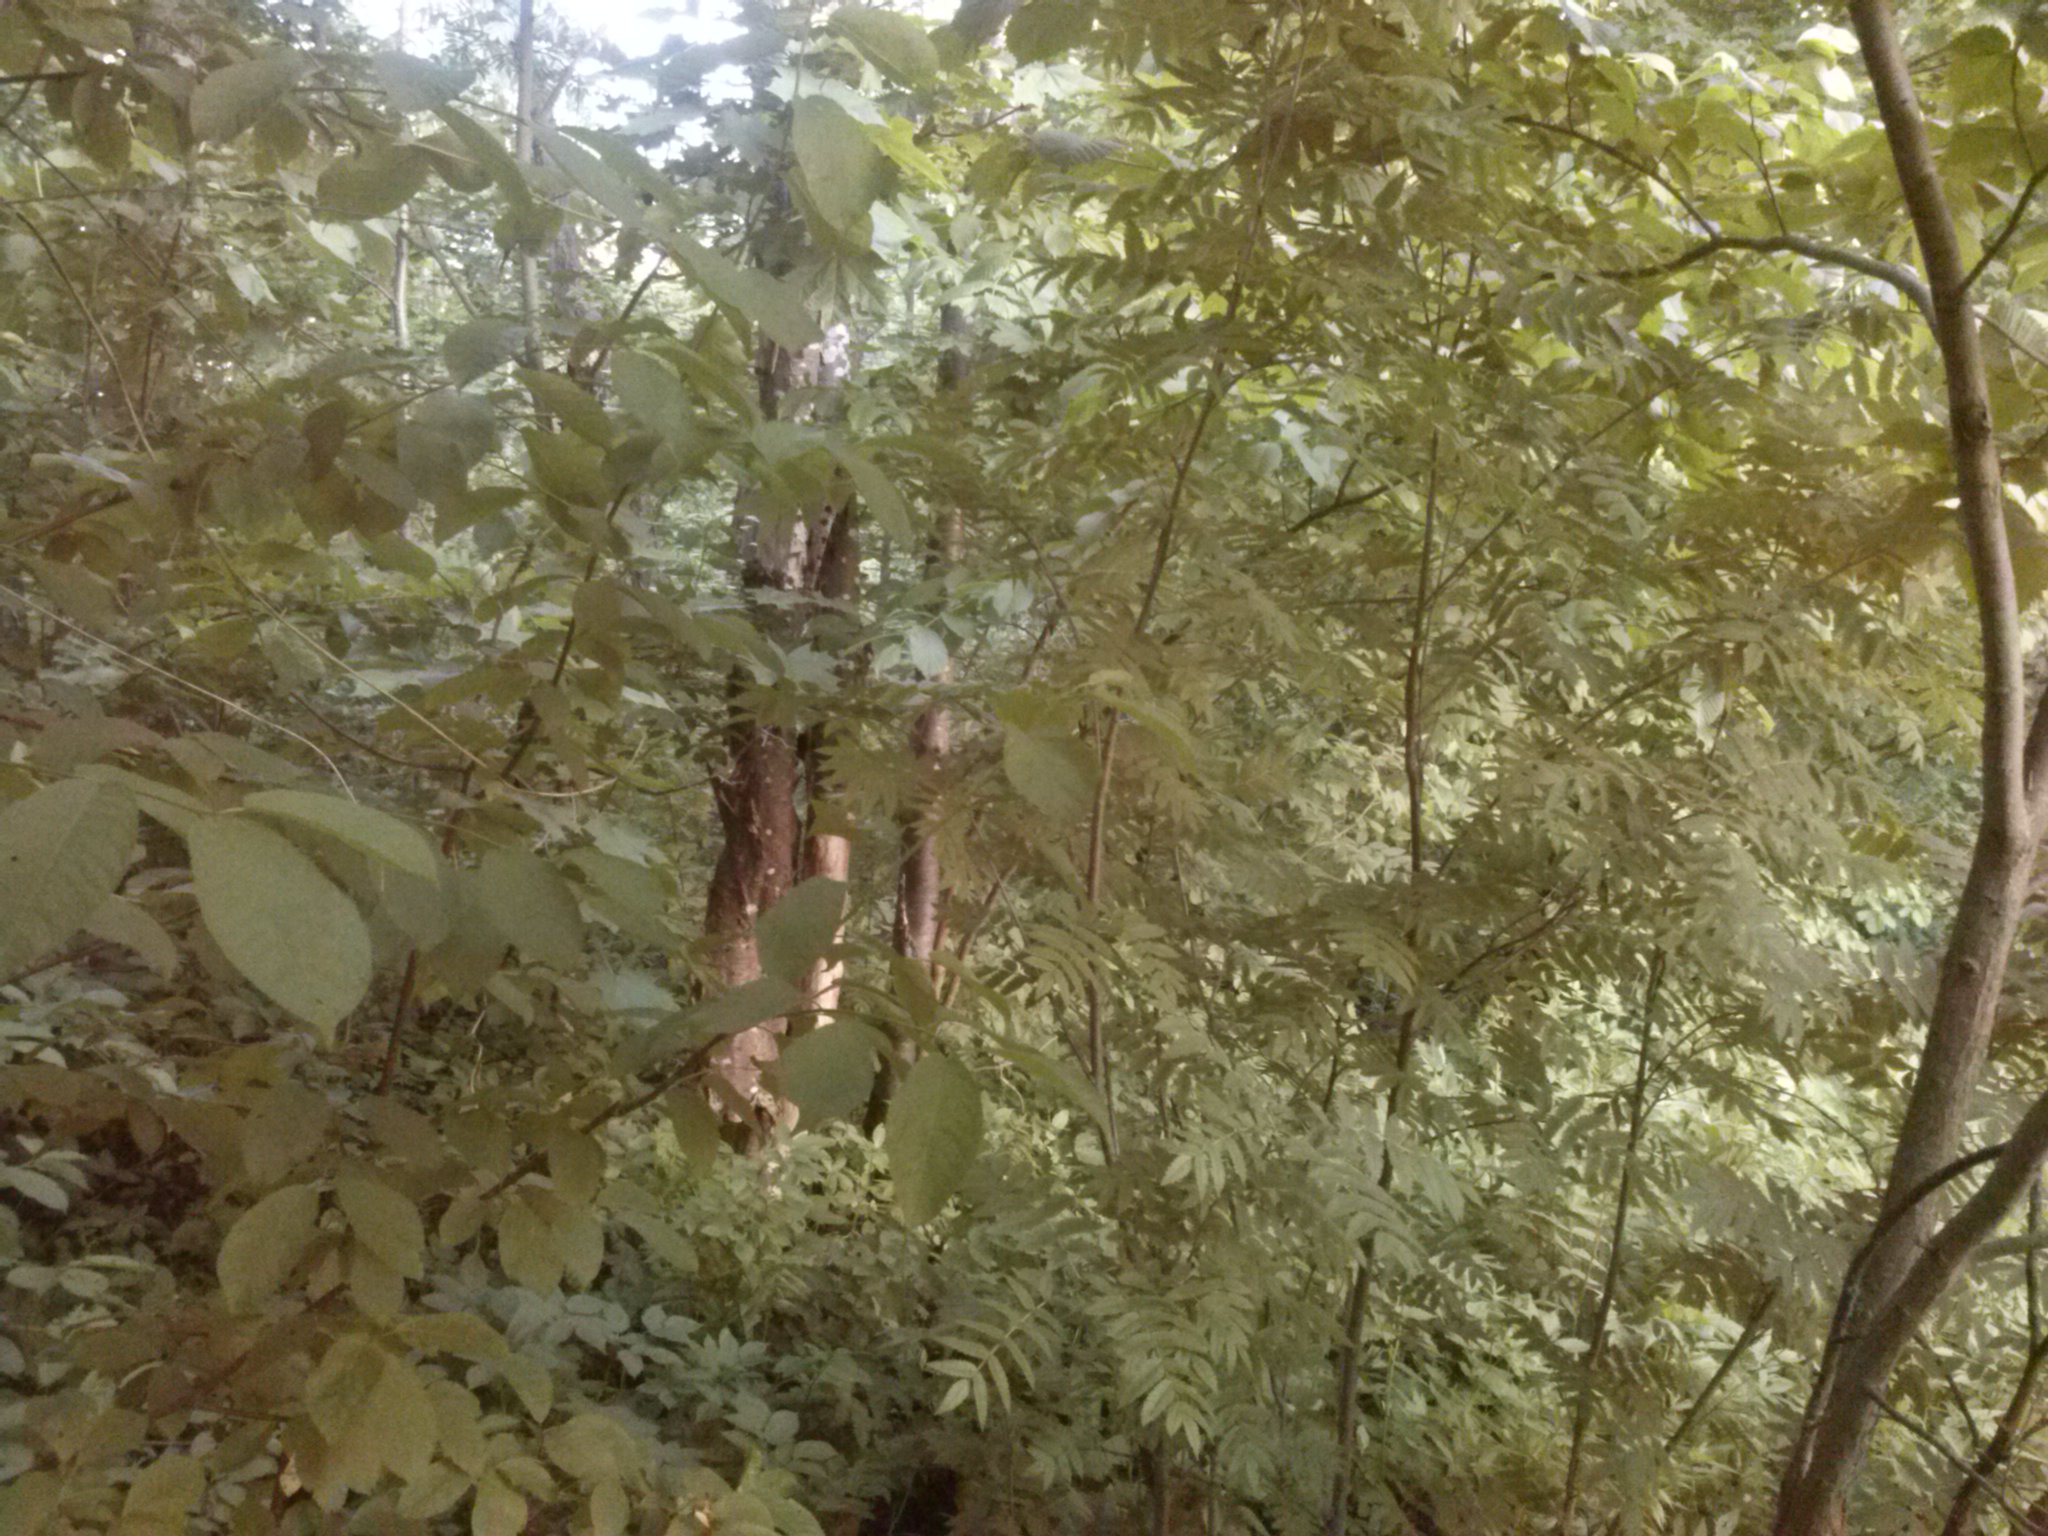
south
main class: Woodland
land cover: Broadleaved woodland
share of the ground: > 75 %
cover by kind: broadleaved forest trees 100 %
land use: Forestry
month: May
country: LV
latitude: 56.3741
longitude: 27.8907
